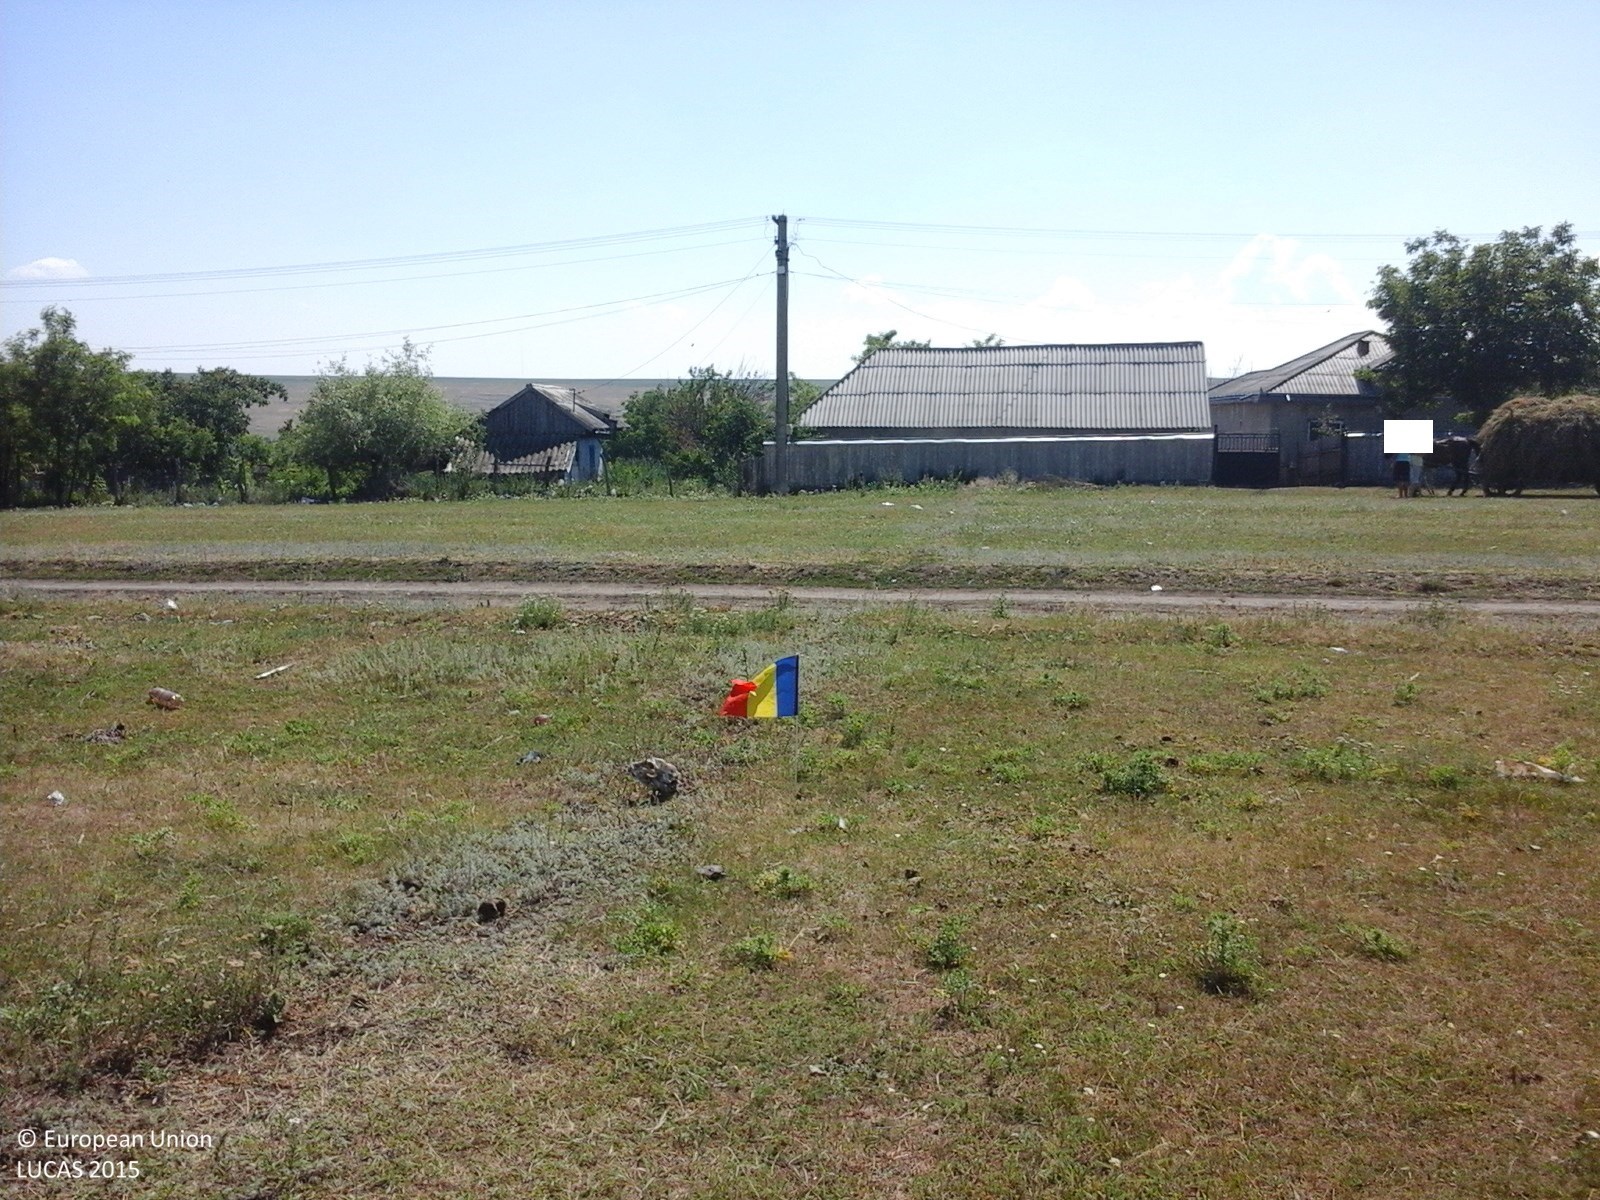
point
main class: Grassland
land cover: Grassland without tree/shrub cover
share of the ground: > 75 %
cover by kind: herbaceous plants 100 %
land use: Agriculture (excluding fallow land and kitchen gardens)
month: June
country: RO
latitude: 47.3107
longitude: 27.1299
